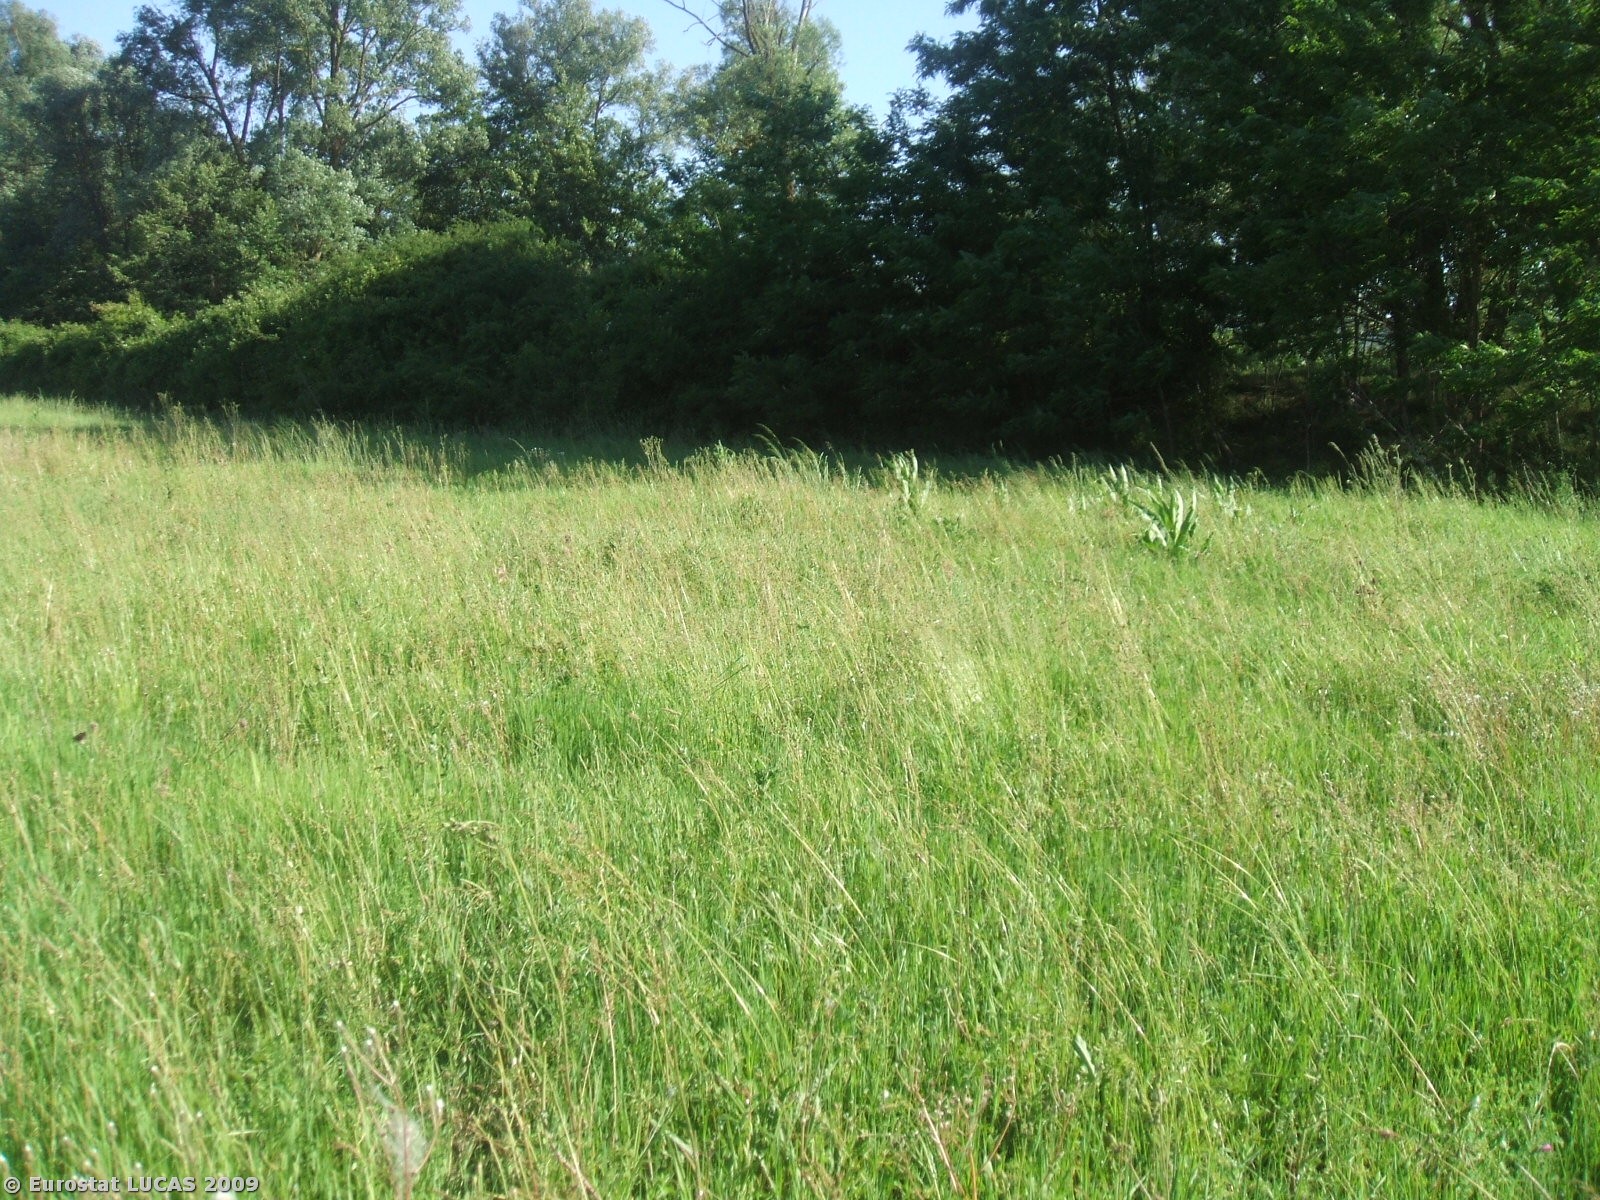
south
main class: Grassland
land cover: Grassland without tree/shrub cover
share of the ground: > 75 %
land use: Fallow land
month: May
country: IT
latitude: 40.3508
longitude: 15.7807
